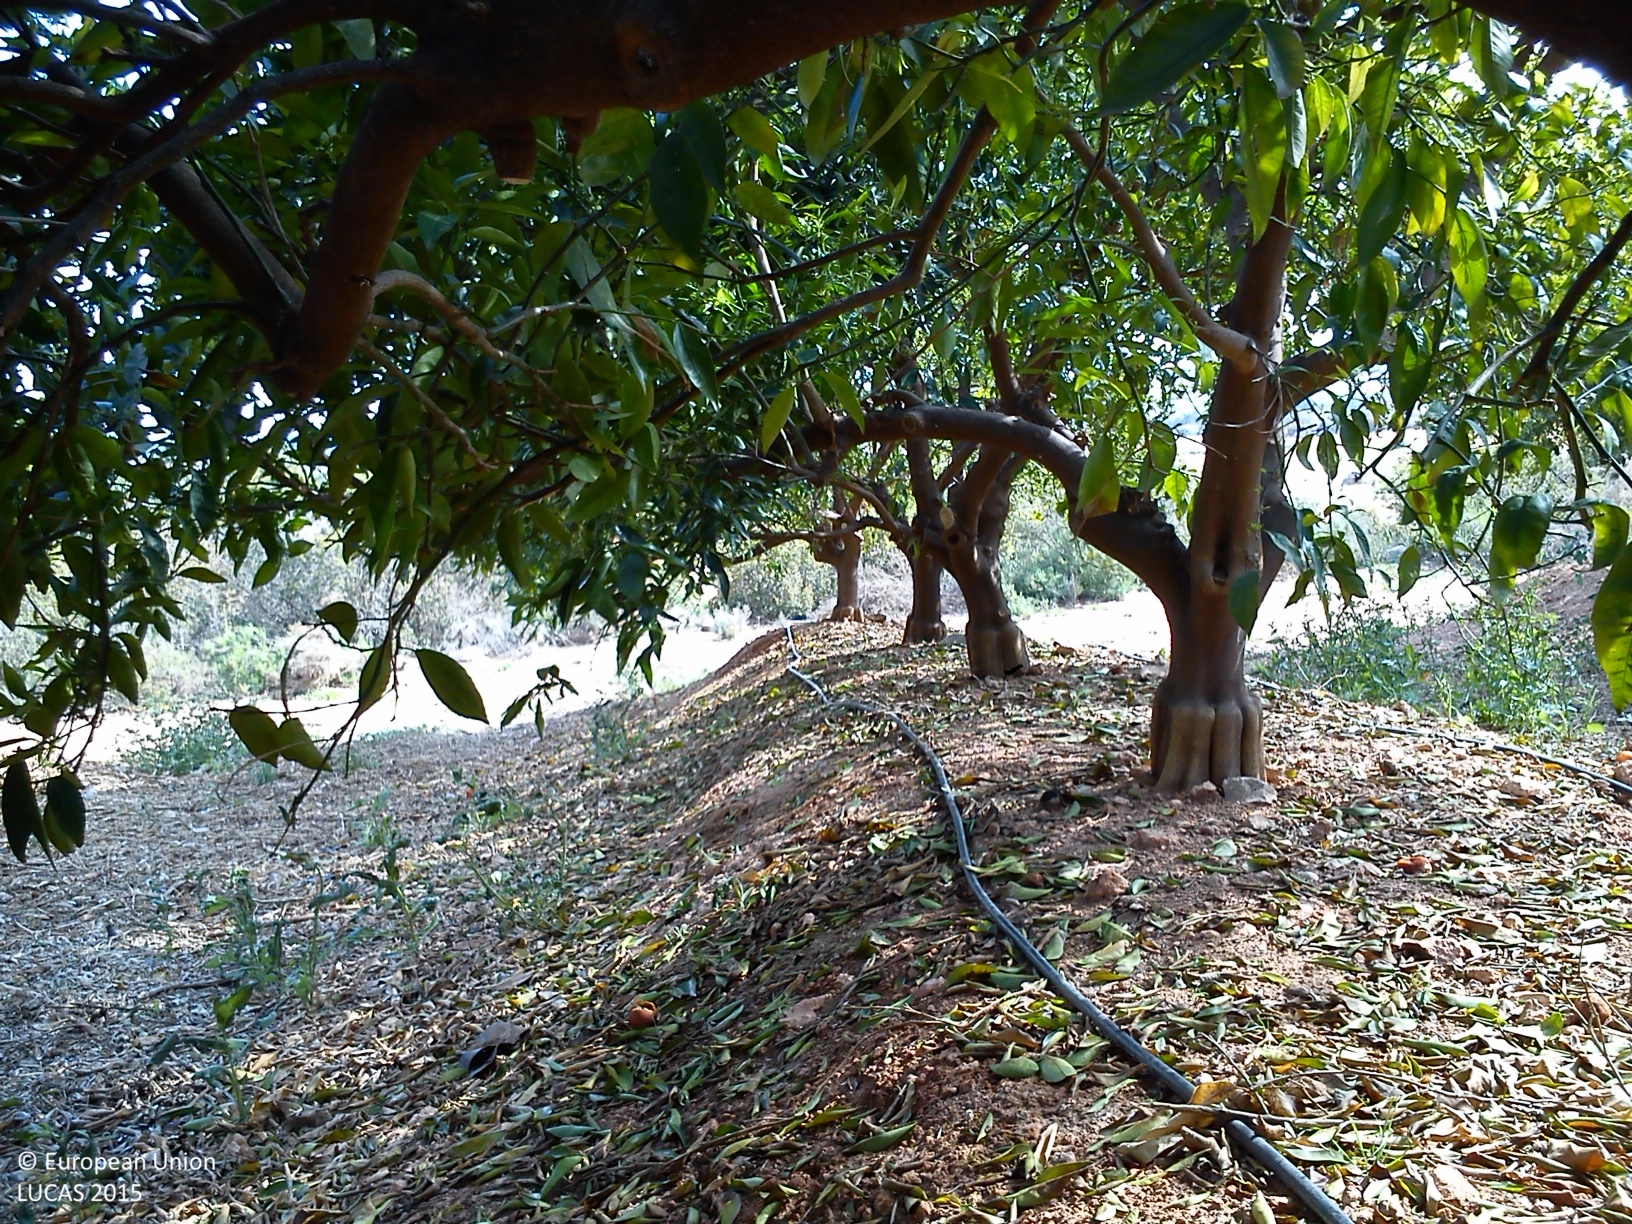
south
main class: Cropland
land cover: Other citrus fruit
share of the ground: 50 - 75 %
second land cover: Other bare soil
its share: > 75 %
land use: Agriculture (excluding fallow land and kitchen gardens)
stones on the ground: 10 - 25 %
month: April
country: ES
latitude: 39.5226
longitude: -0.6430
